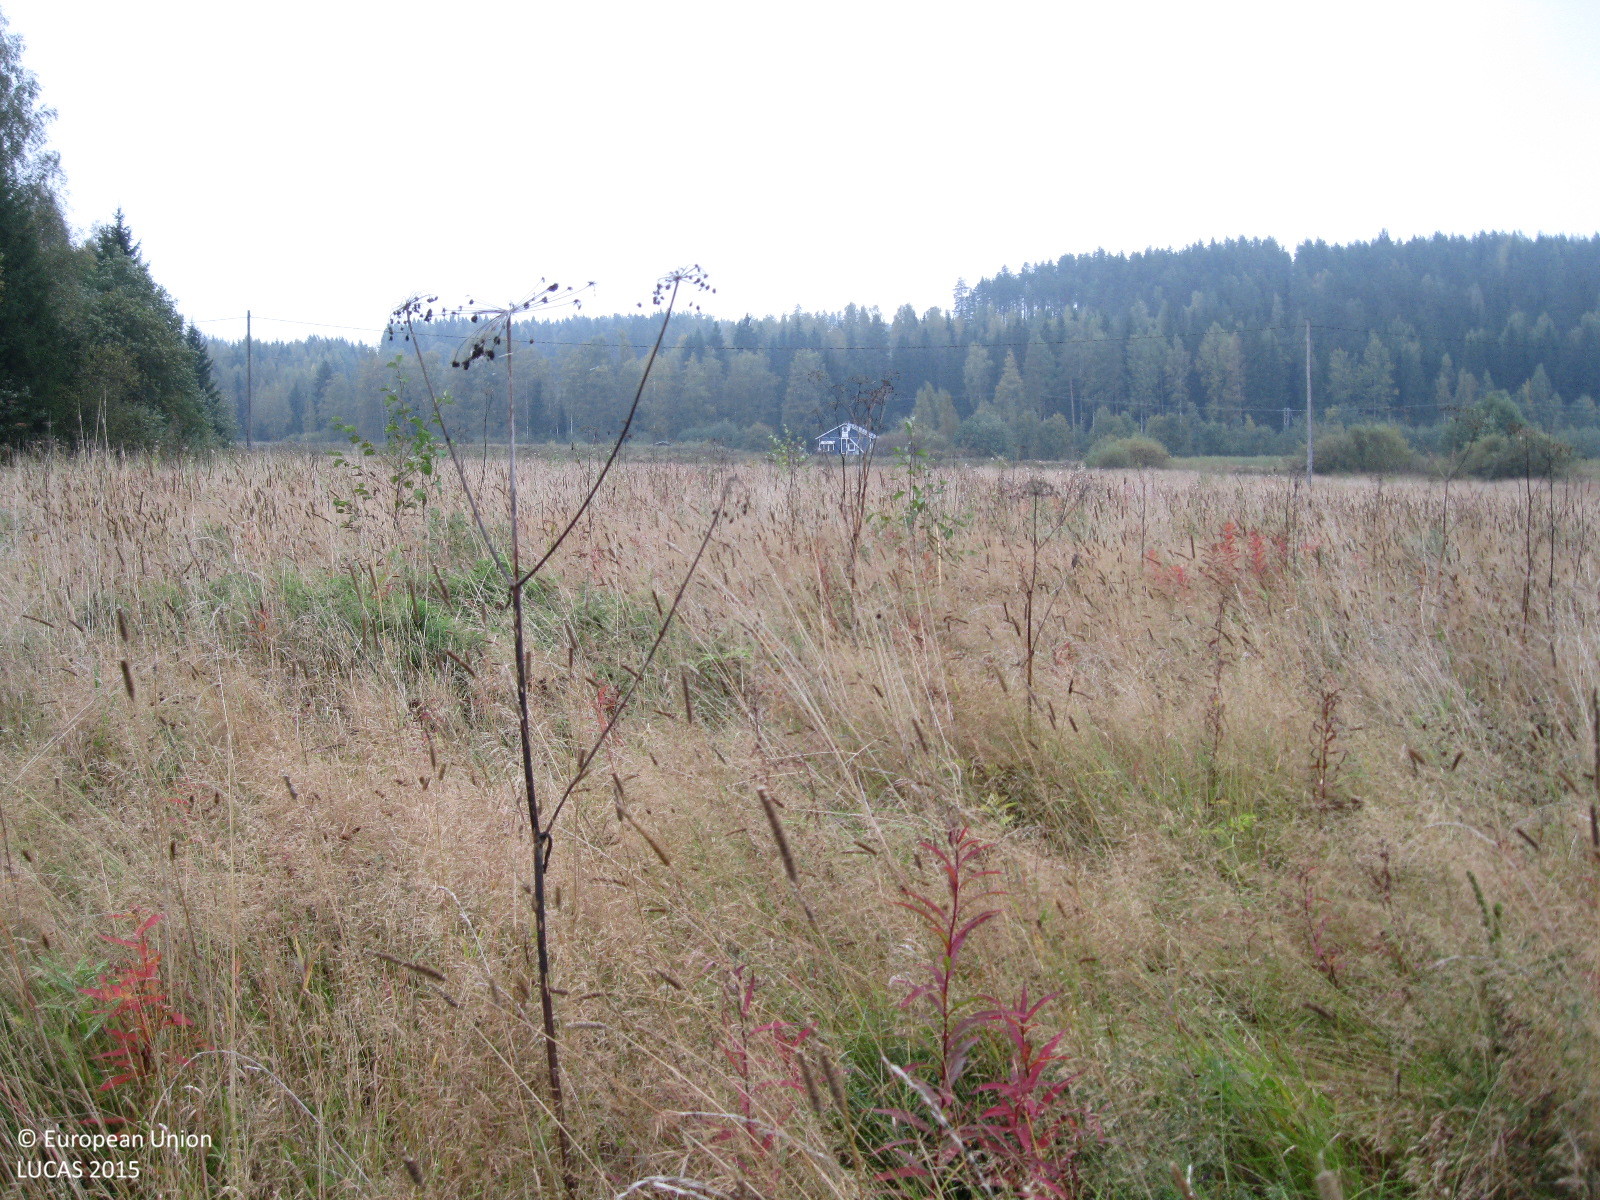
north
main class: Grassland
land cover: Spontaneously vegetated surfaces
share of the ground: > 75 %
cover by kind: herbaceous plants 100 %
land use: Fallow land
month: September
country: FI
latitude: 60.8712
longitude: 24.9006
